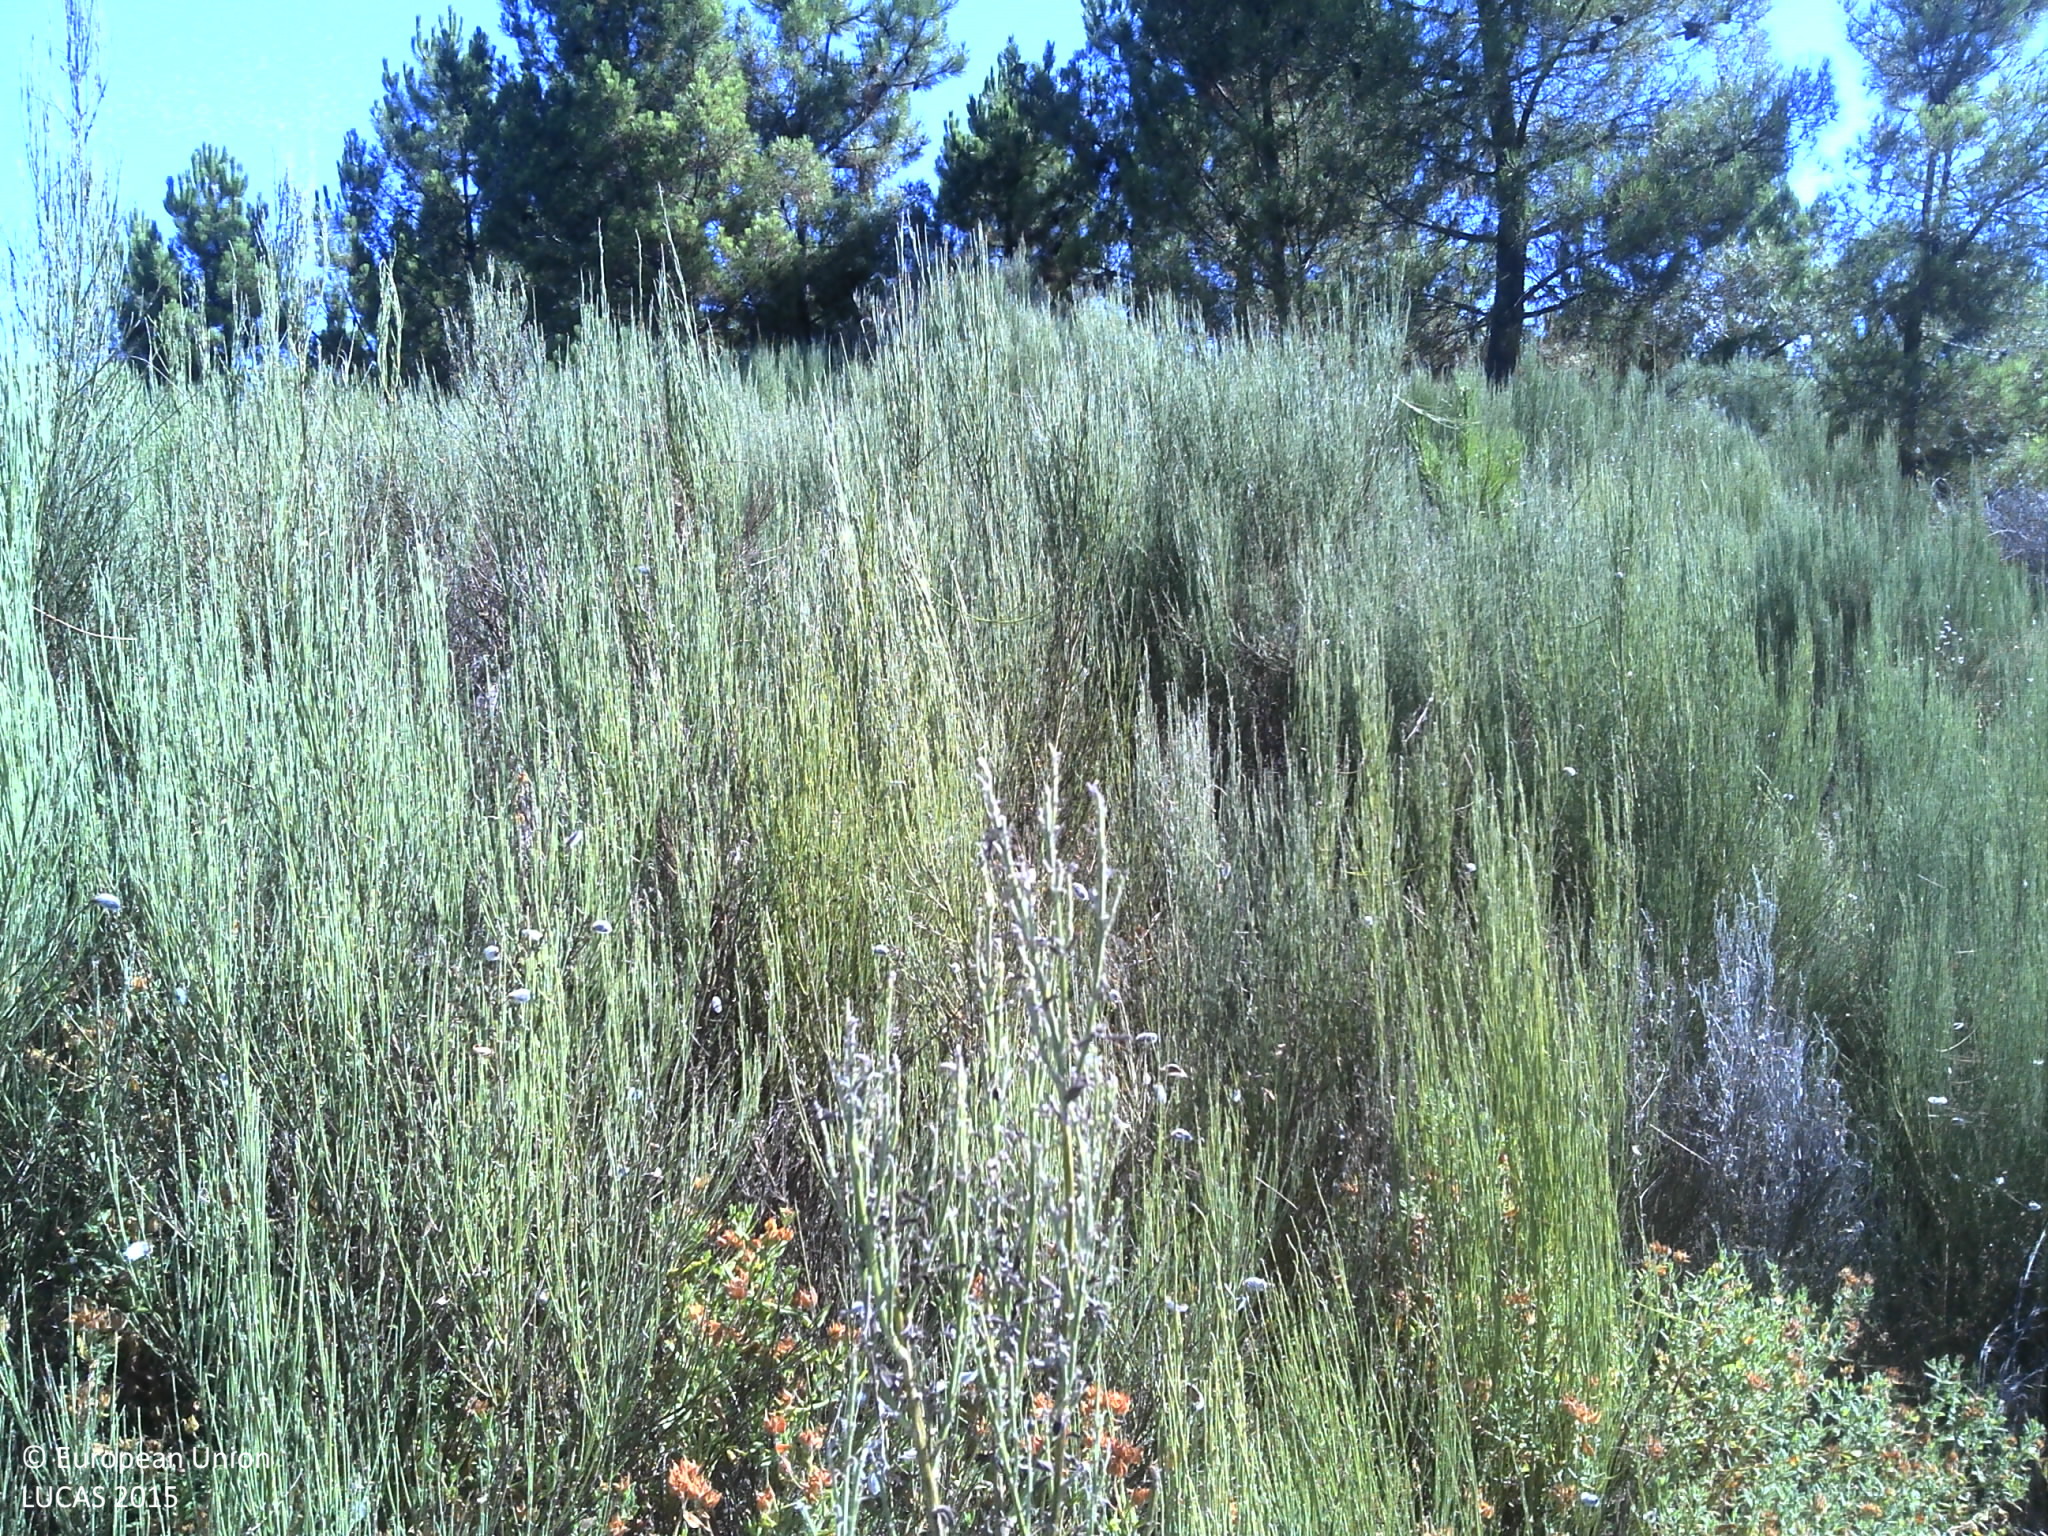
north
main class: Shrubland
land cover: Shrubland without tree cover
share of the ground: > 75 %
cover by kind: shrubs 100 %
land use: Semi-natural and natural areas not in use
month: July
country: PT
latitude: 41.3048
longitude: -7.4777
